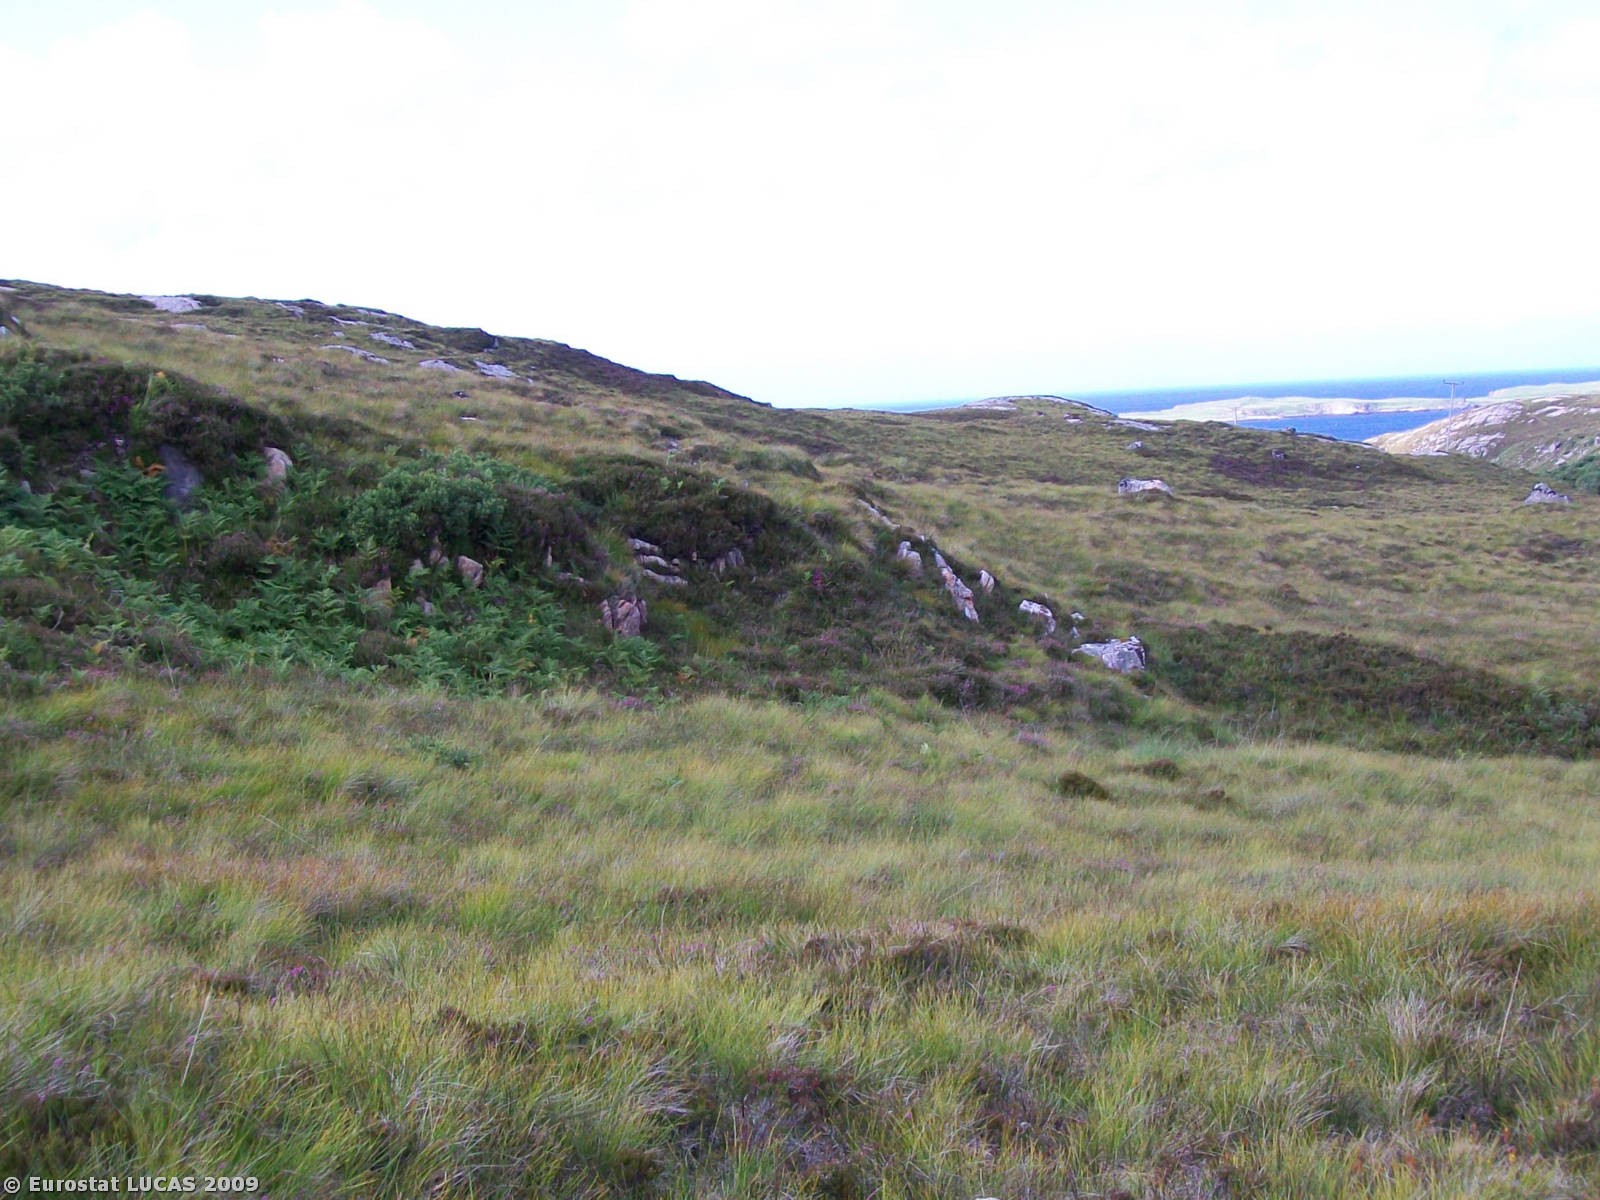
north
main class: Shrubland
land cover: Shrubland without tree cover
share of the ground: > 75 %
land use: Unused
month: July
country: GB
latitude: 58.5444
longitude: -4.6752
